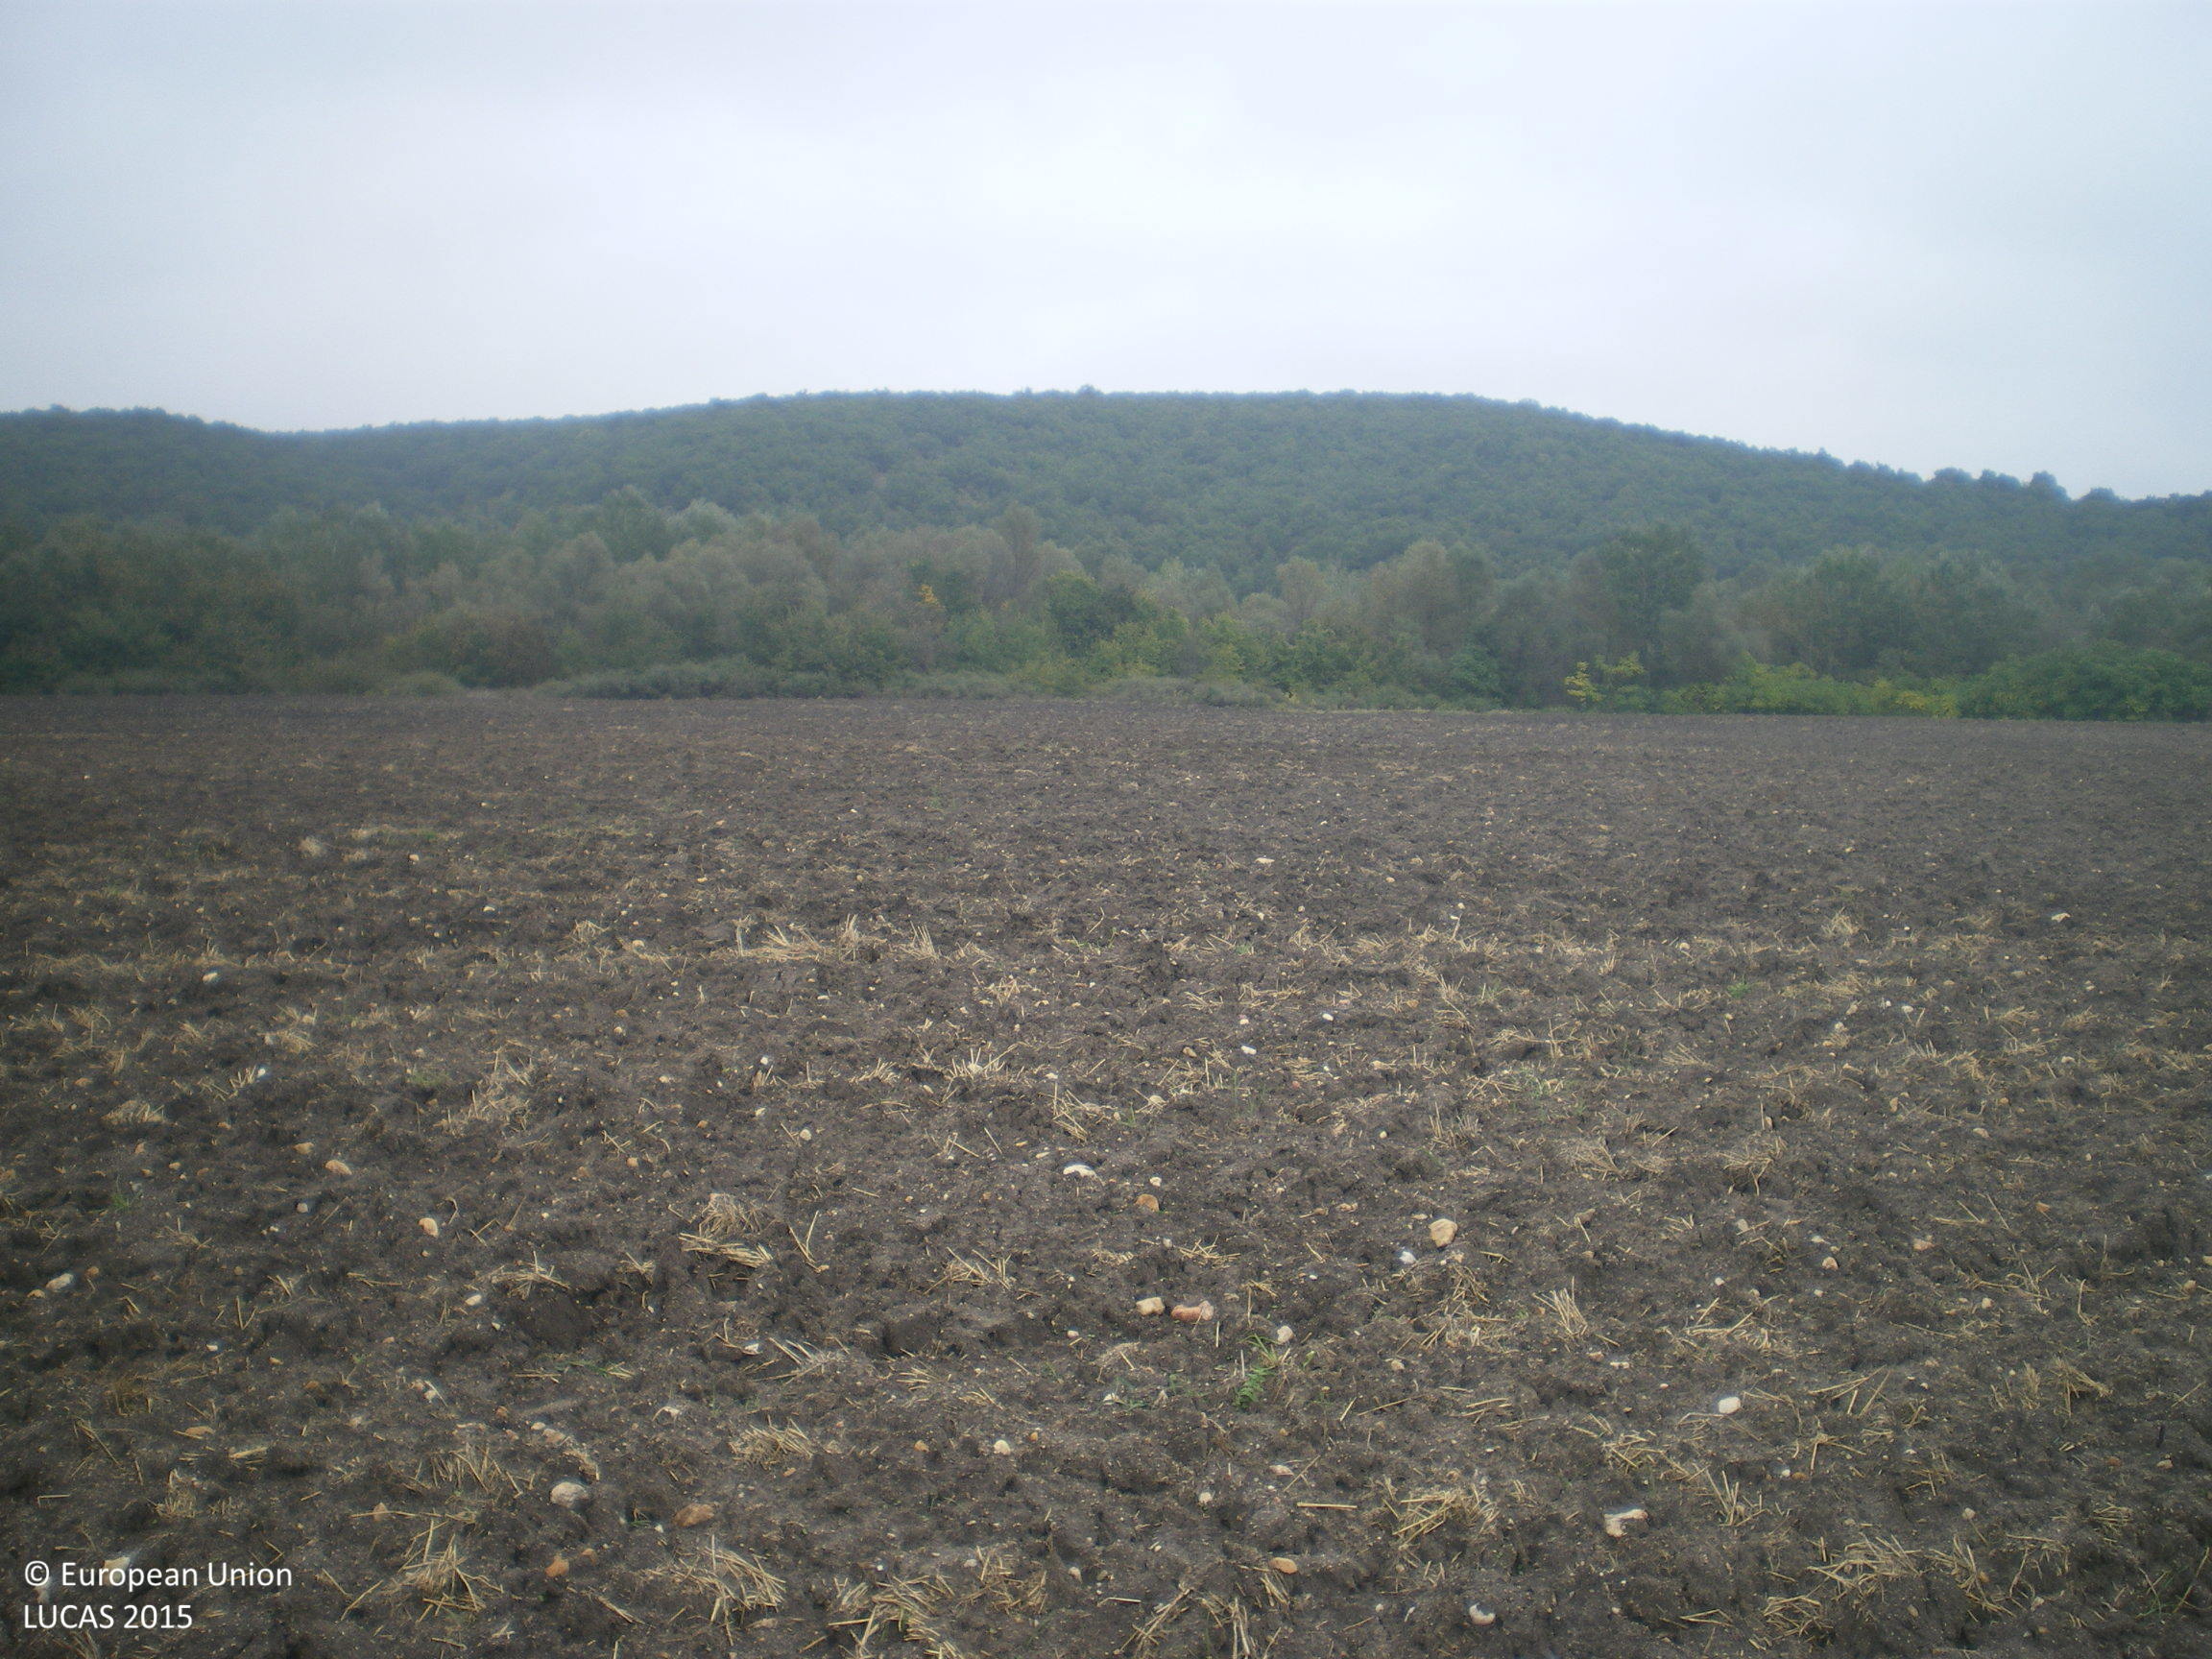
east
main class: Cropland
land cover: Common wheat
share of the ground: < 10 %
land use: Agriculture (excluding fallow land and kitchen gardens)
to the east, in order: Common wheat; Broadleaved woodland; Tracks; Ditches and canals; Tracks; Broadleaved woodland
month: October
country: BG
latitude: 41.8184
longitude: 26.1960
